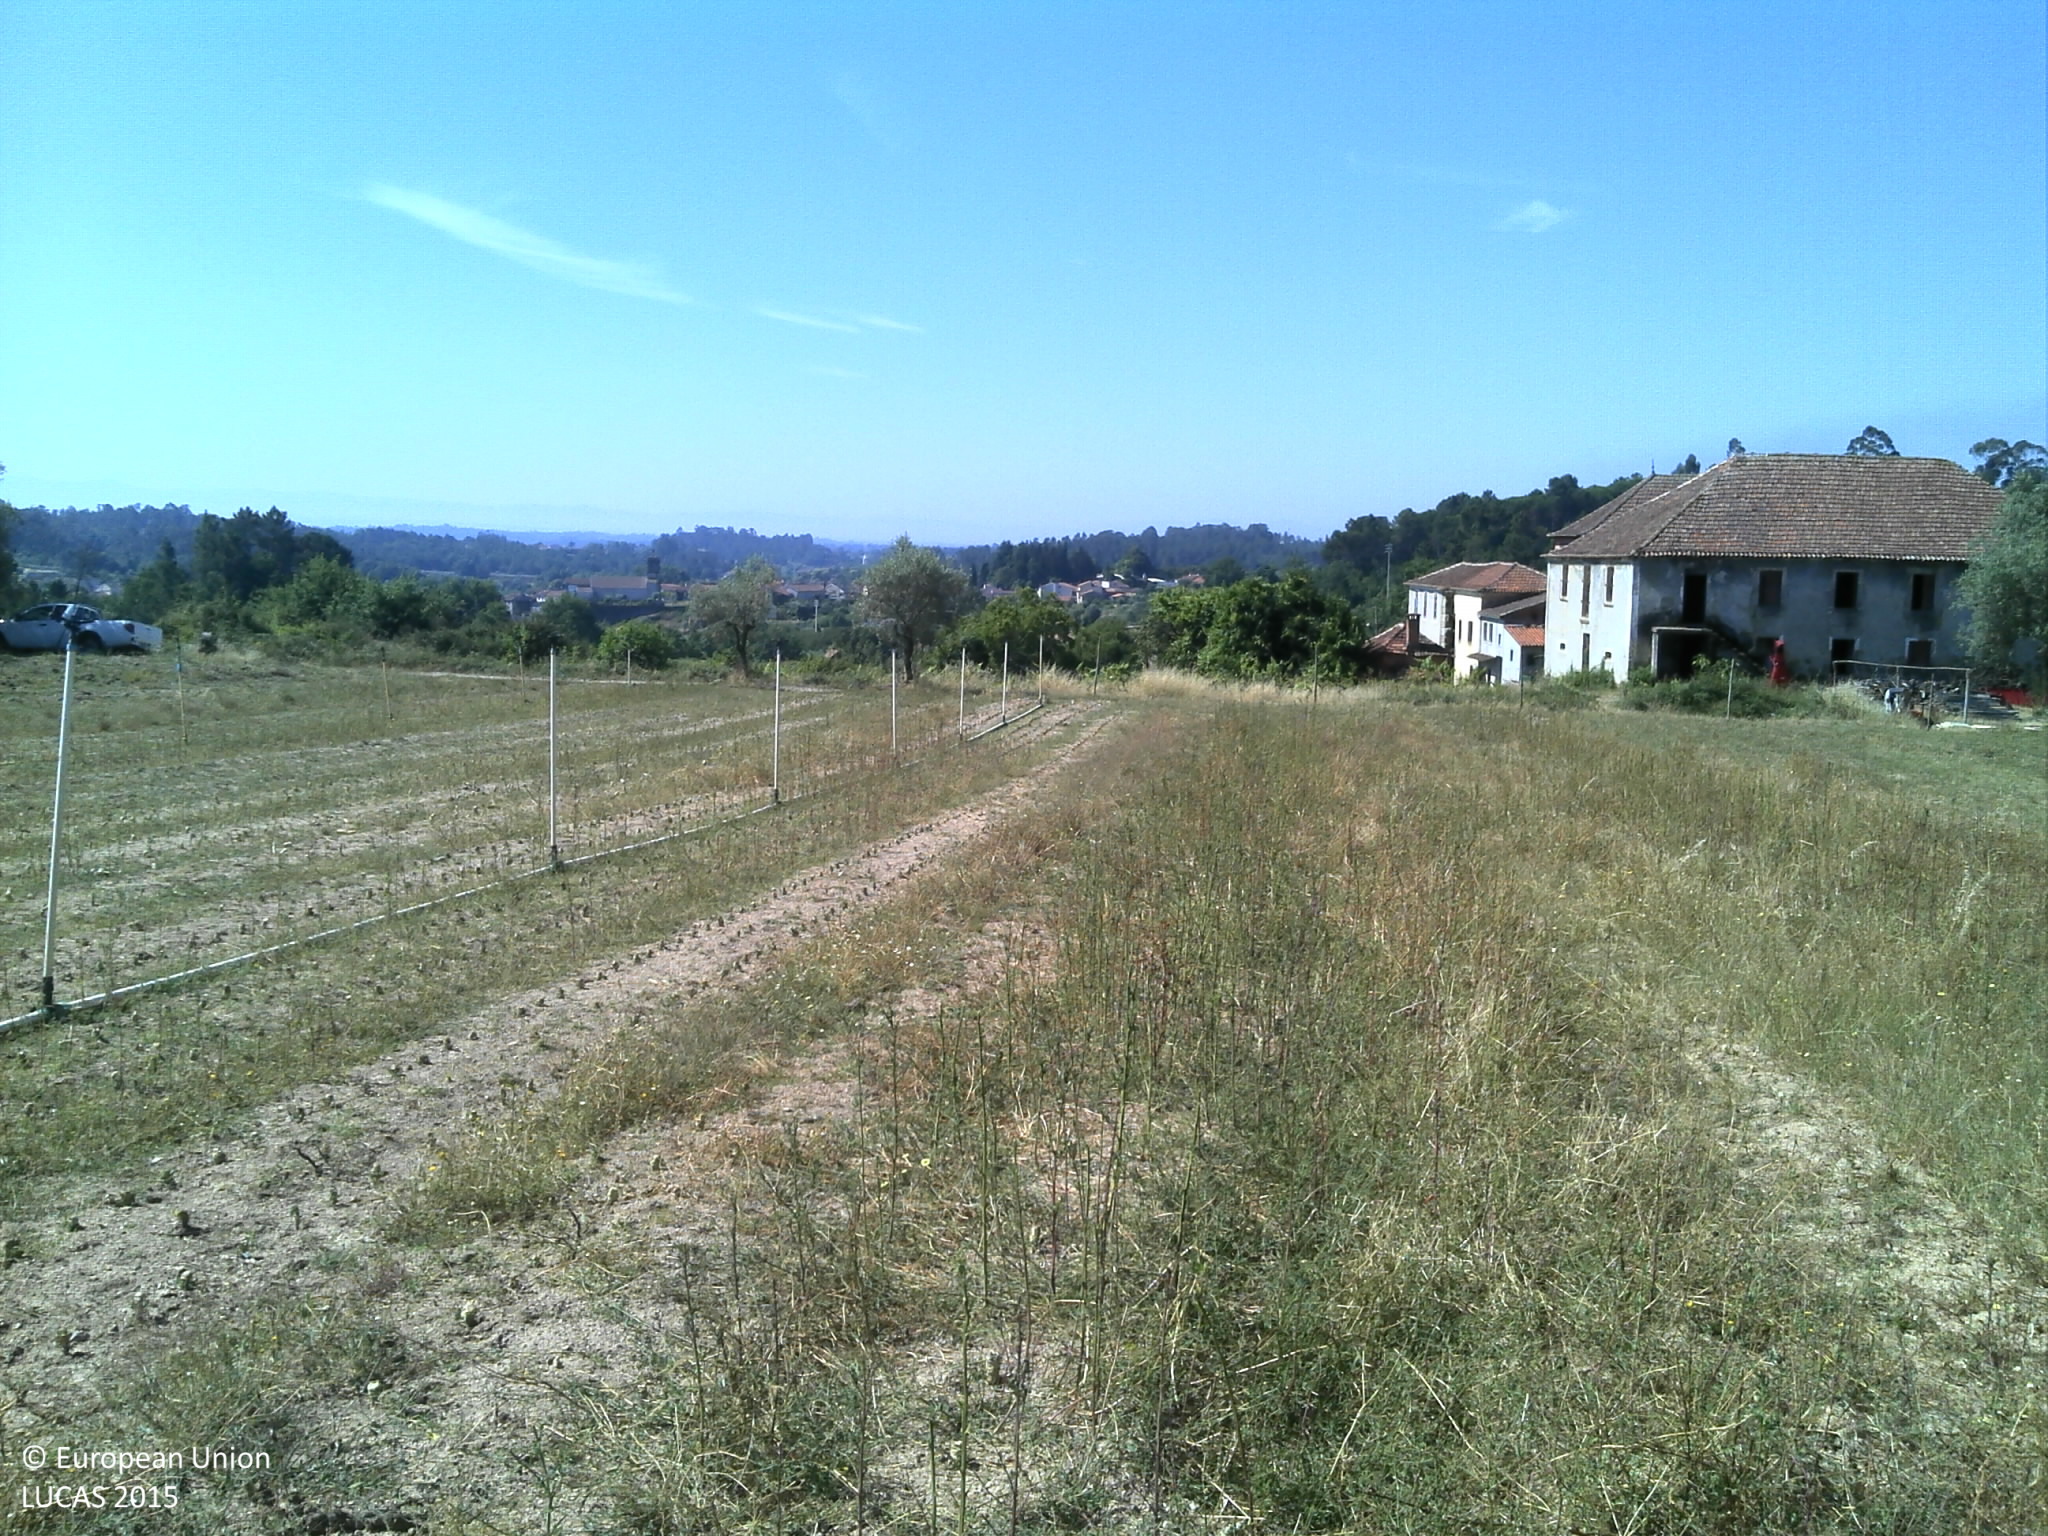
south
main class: Grassland
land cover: Spontaneously vegetated surfaces
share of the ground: > 75 %
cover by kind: herbaceous plants 75 %, unconsolidated bare surface 25 %
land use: Agriculture (excluding fallow land and kitchen gardens)
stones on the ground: < 10 %
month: June
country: PT
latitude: 40.5956
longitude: -8.0285
